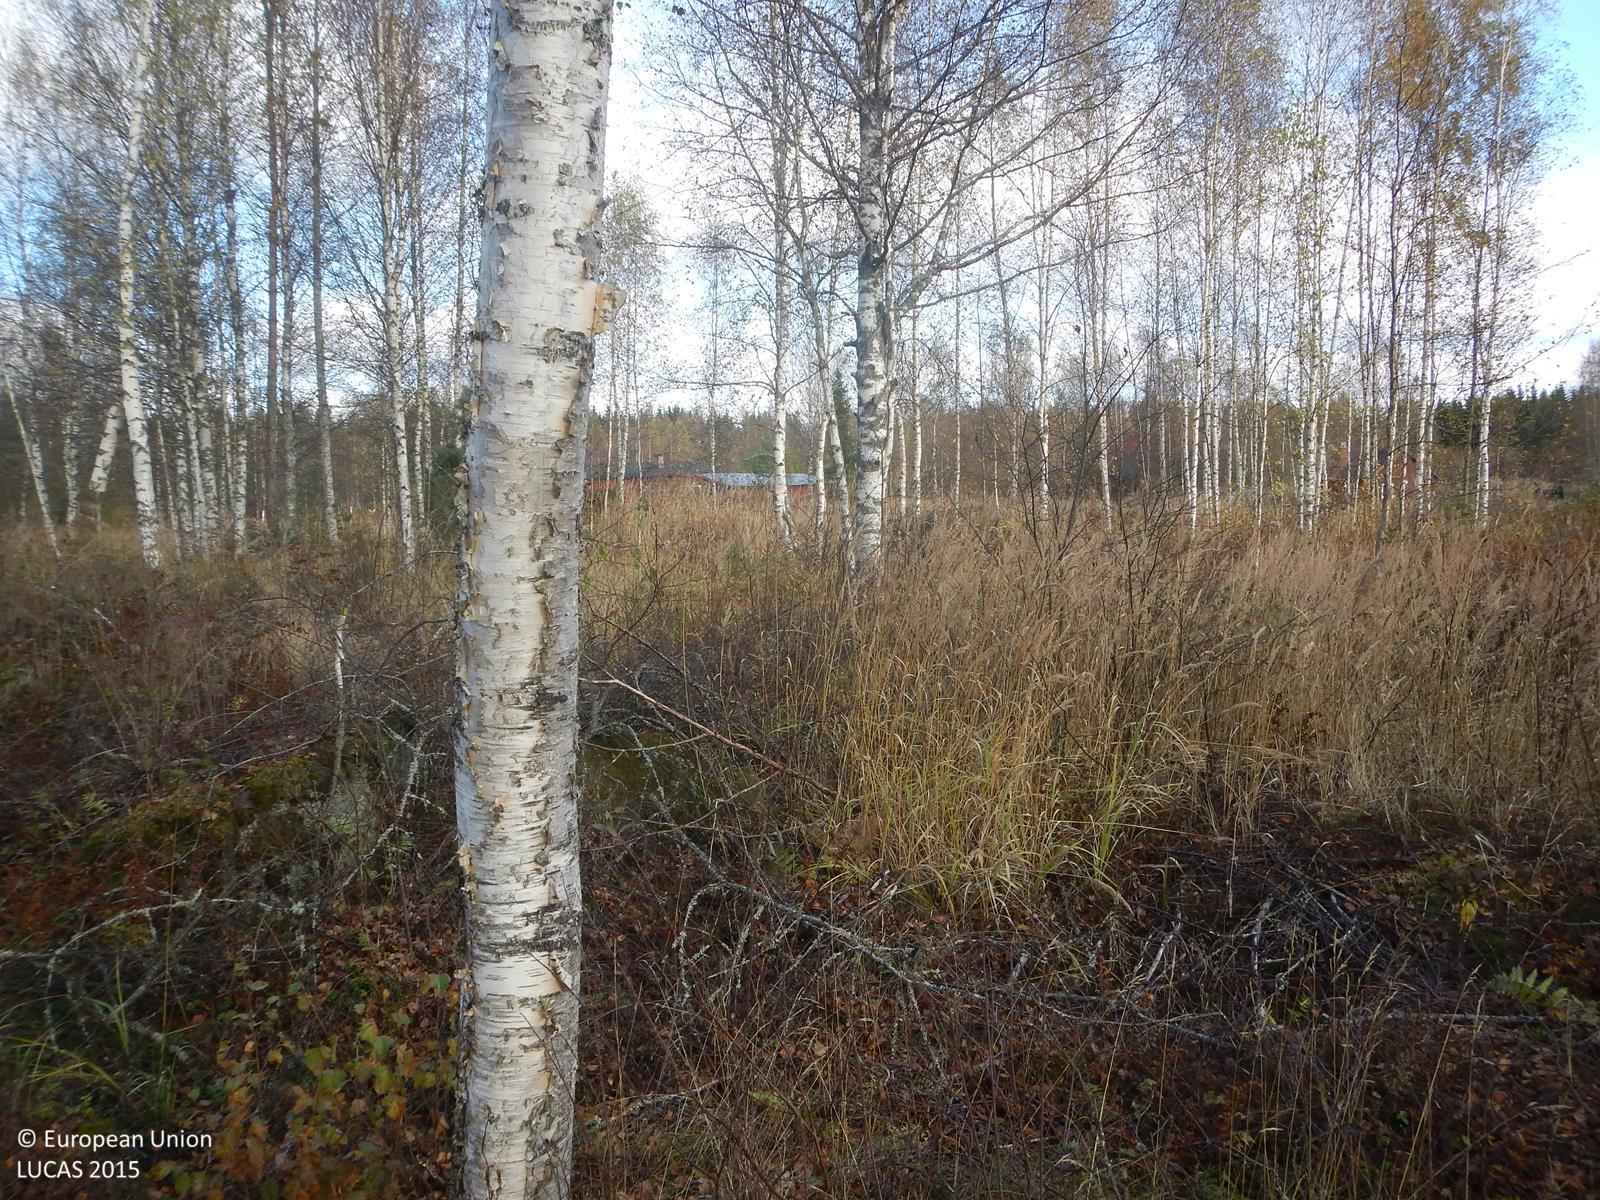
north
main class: Woodland
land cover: Broadleaved woodland
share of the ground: 25 - 50 %
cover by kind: broadleaved forest trees 40 %, herbaceous plants 20 %, shrubs 10 %, lichens and mosses 10 %, consolidated bare surface 10 %
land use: Forestry
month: October
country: FI
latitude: 61.6317
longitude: 25.8831
